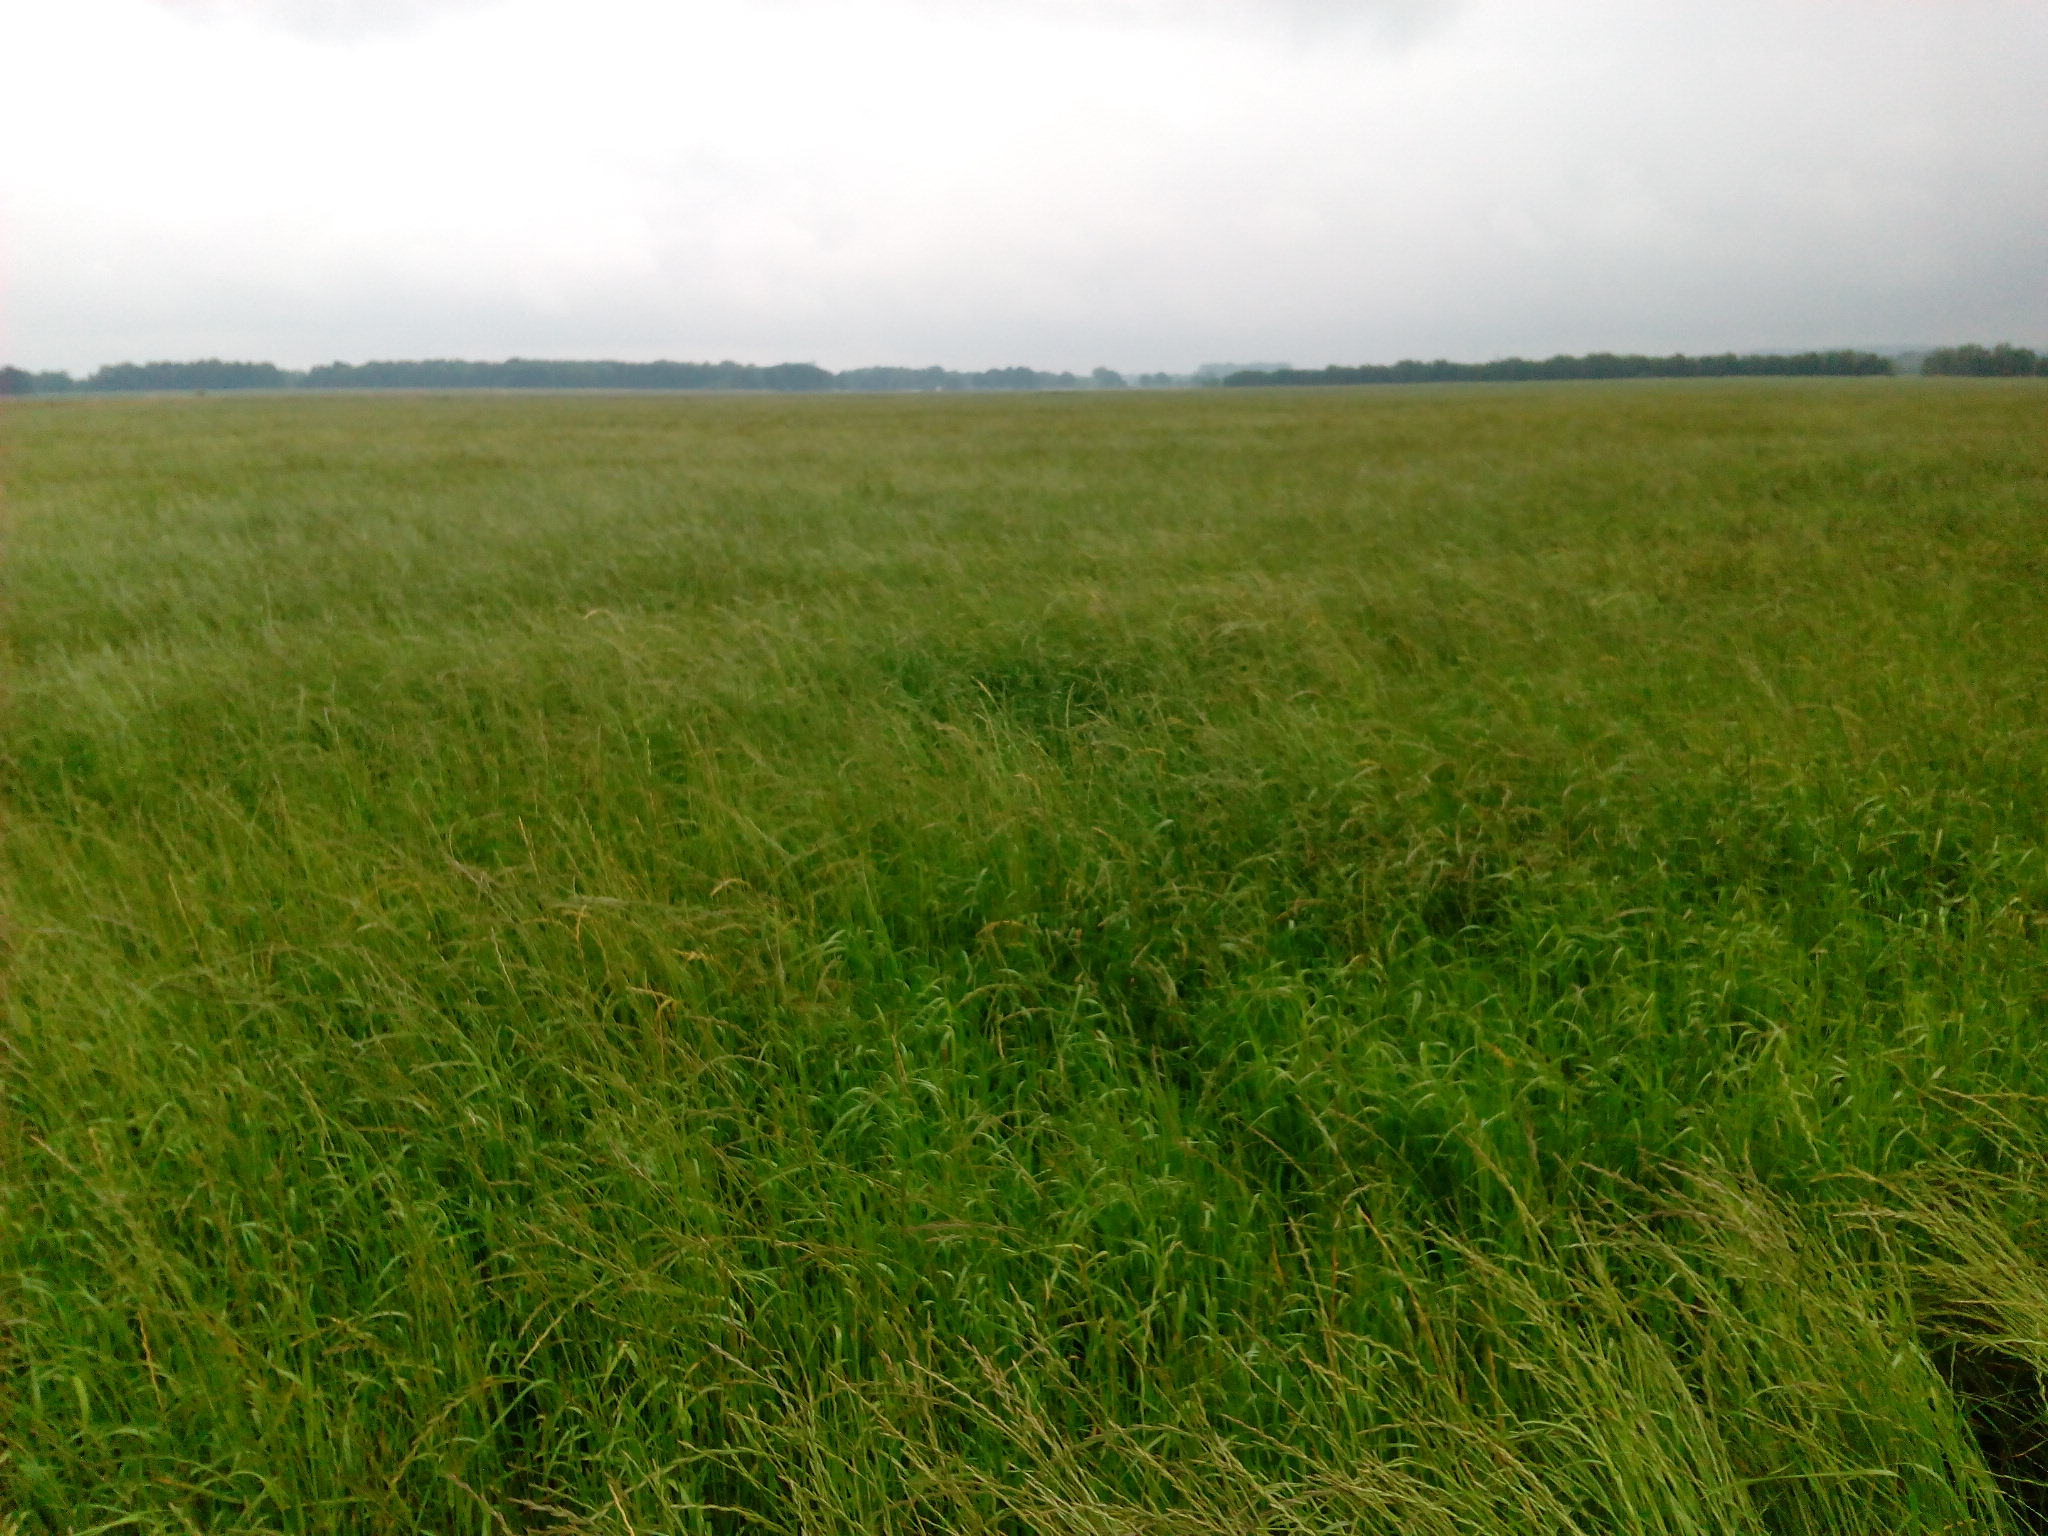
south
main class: Cropland
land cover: Temporary grasslands
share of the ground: > 75 %
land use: Agriculture (excluding fallow land and kitchen gardens)
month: June
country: DE
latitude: 53.0365
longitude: 13.1763
